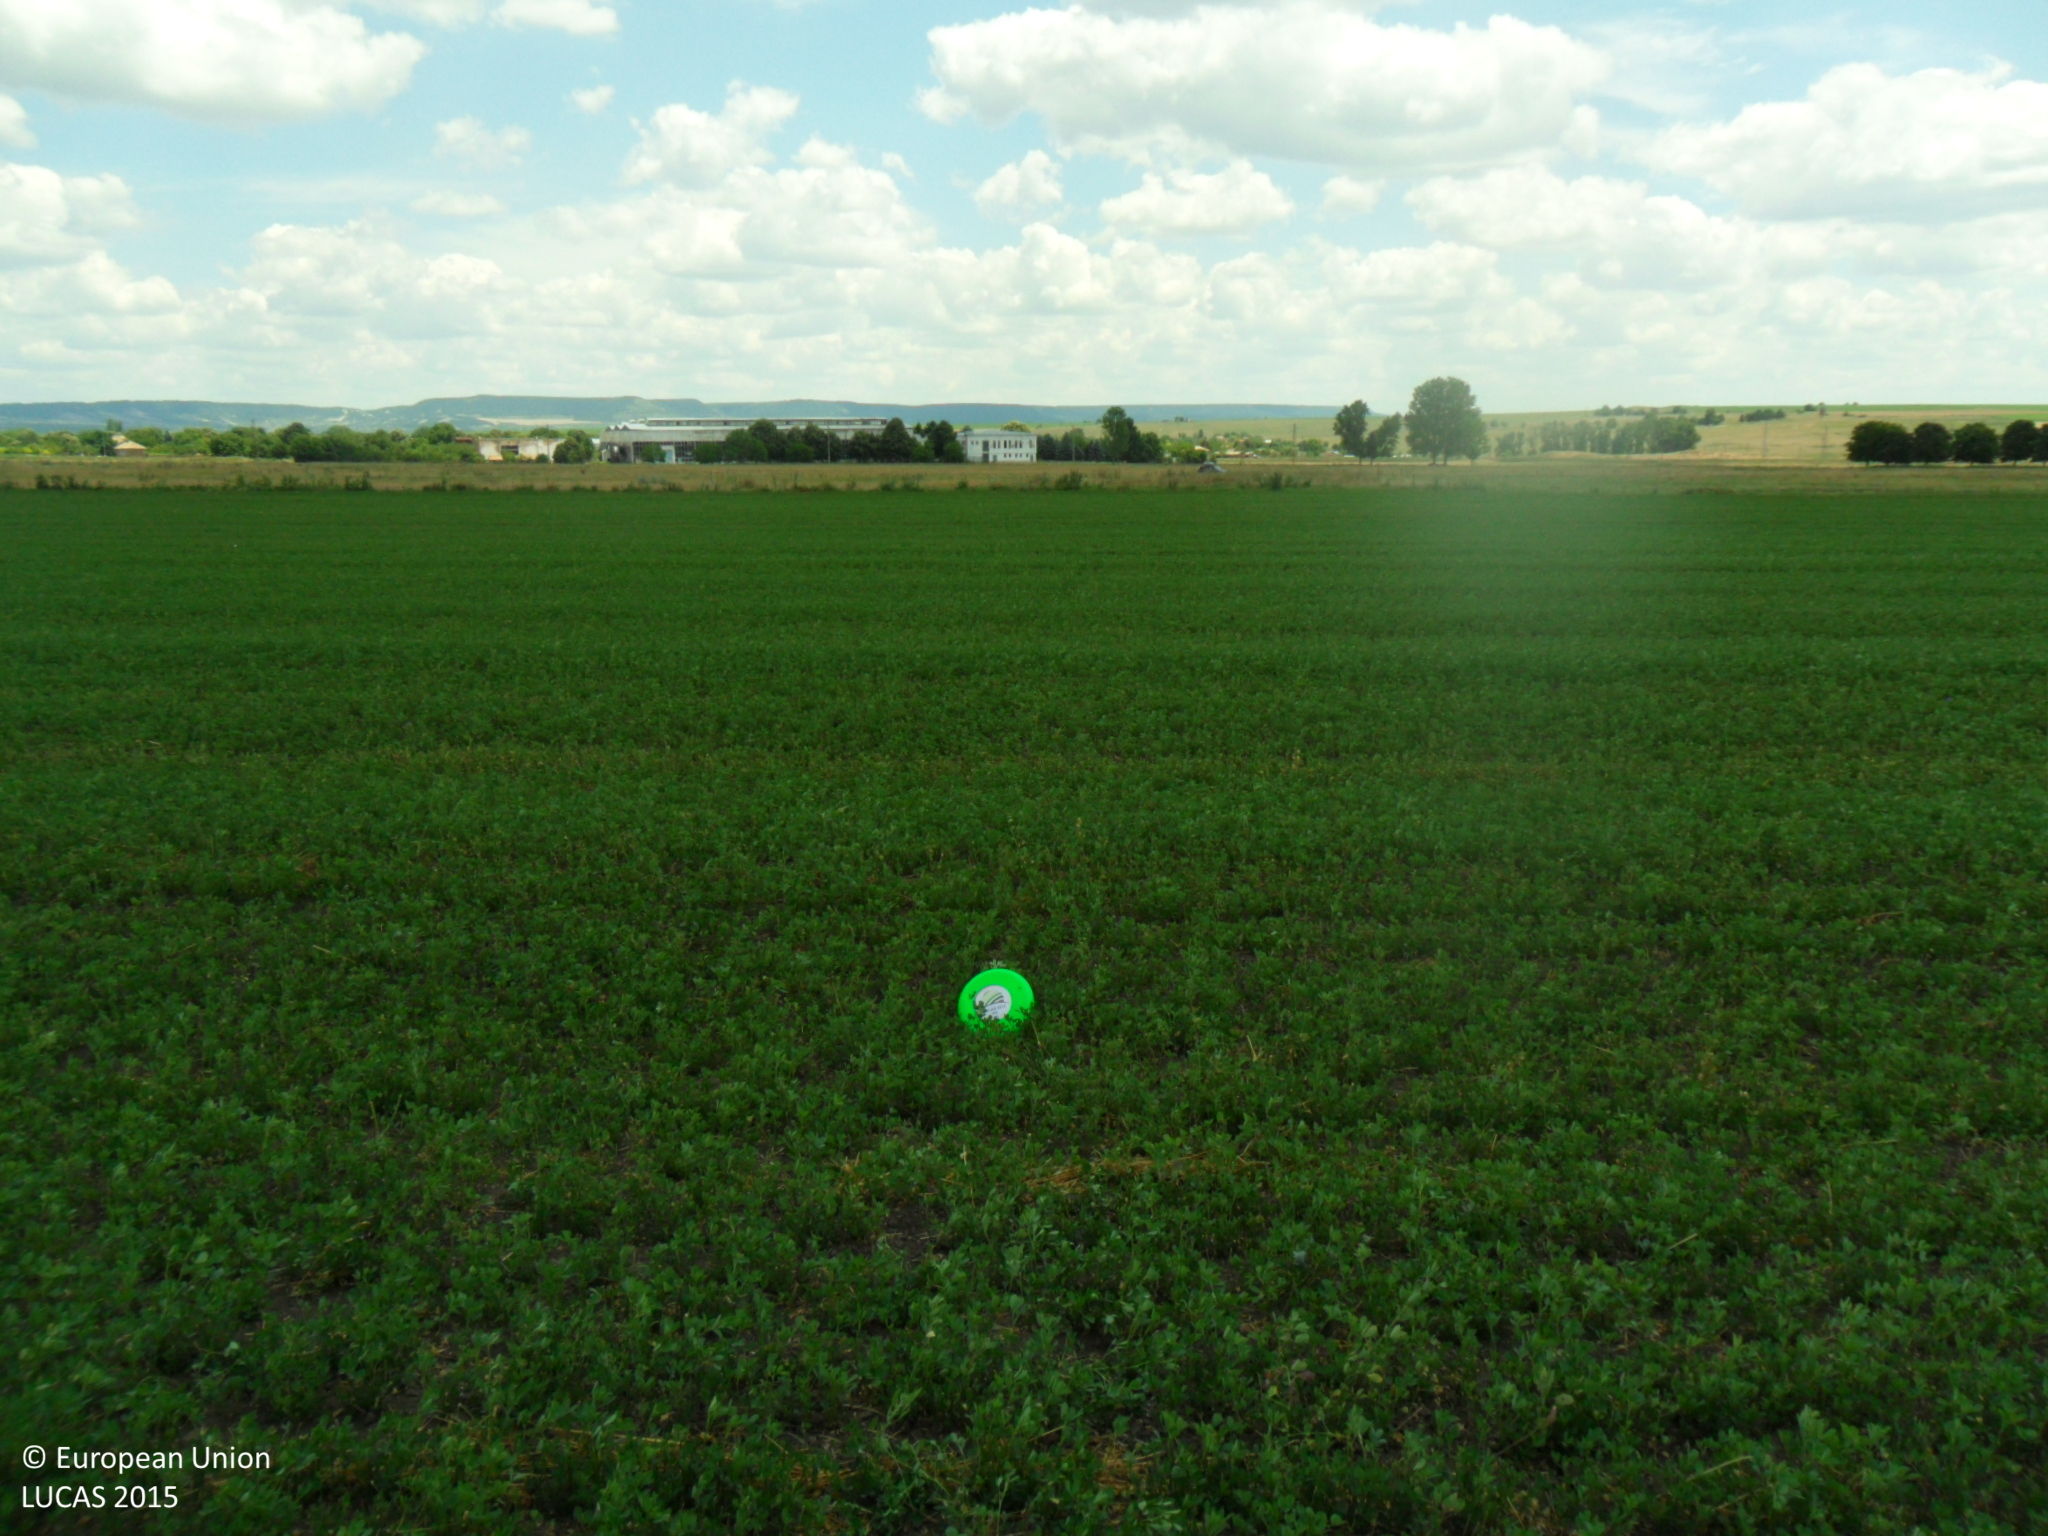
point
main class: Cropland
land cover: Lucerne
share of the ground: > 75 %
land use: Agriculture (excluding fallow land and kitchen gardens)
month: June
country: BG
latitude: 43.3585
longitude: 27.1090
